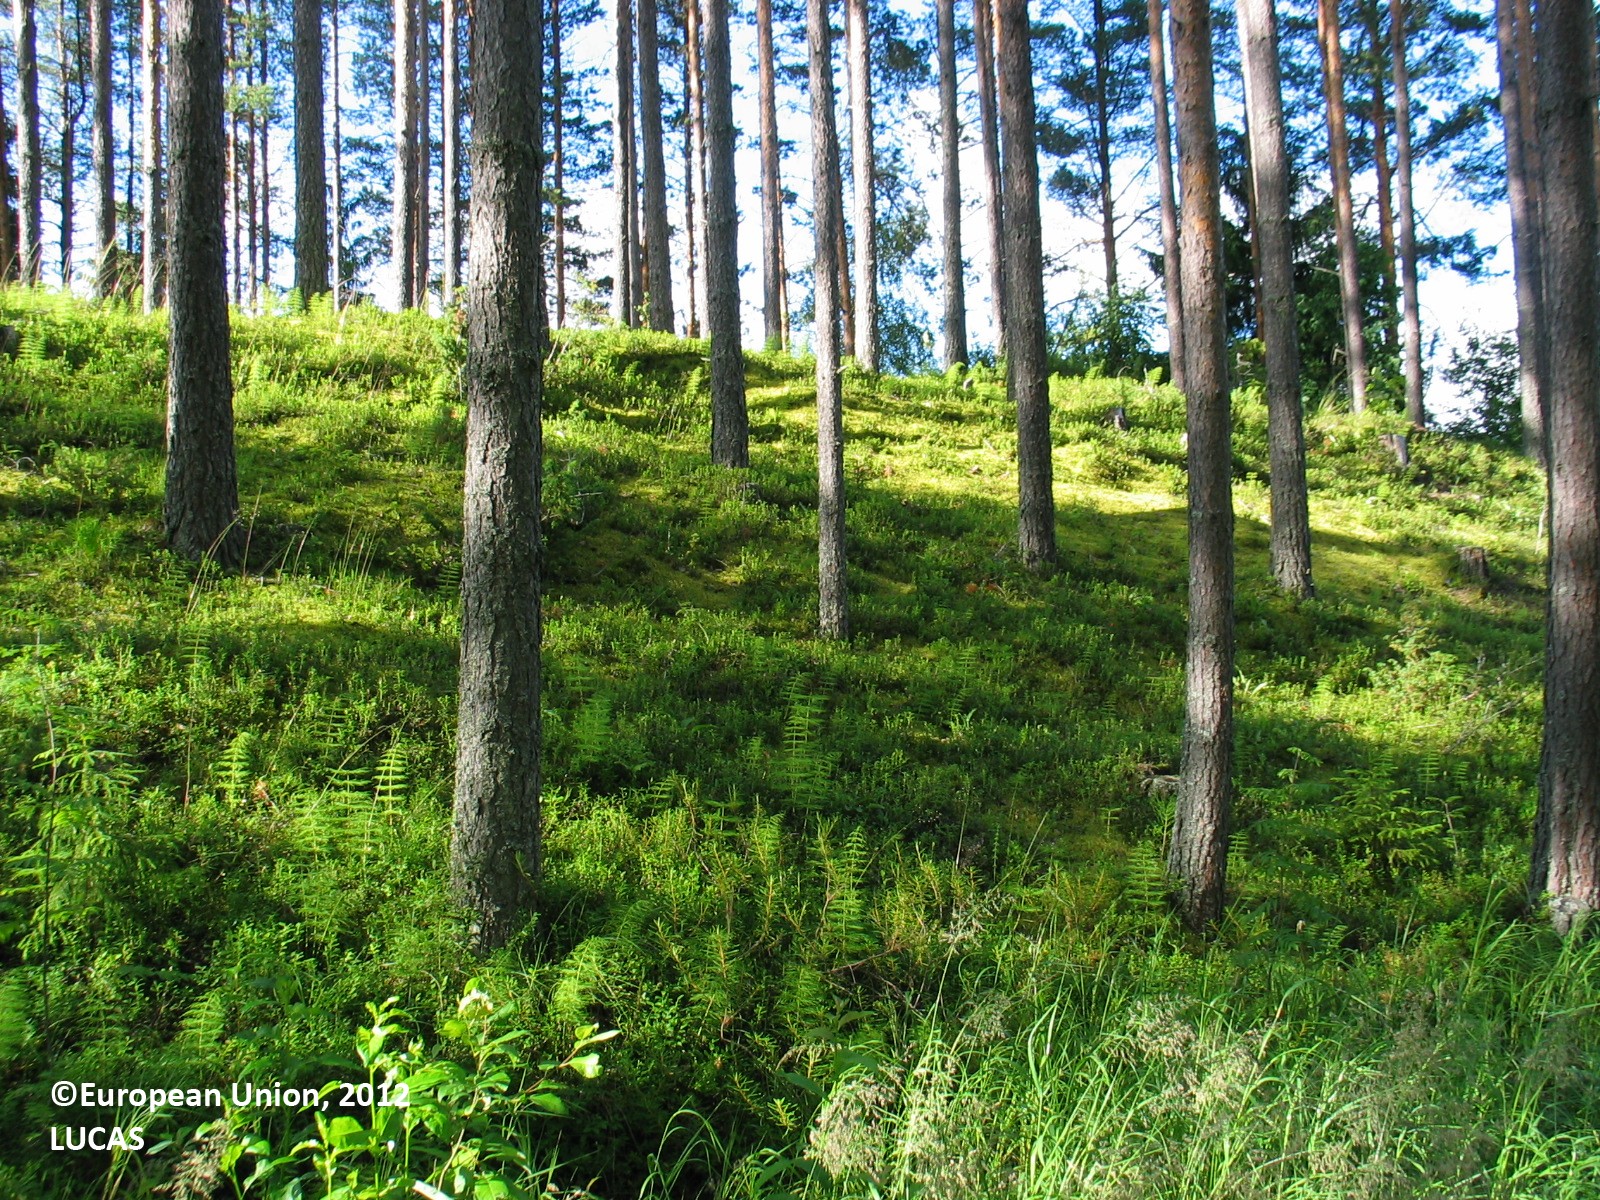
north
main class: Grassland
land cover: Grassland without tree/shrub cover
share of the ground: > 75 %
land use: Amenities, museums, leisure
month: July
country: FI
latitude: 64.6691
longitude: 26.5581
